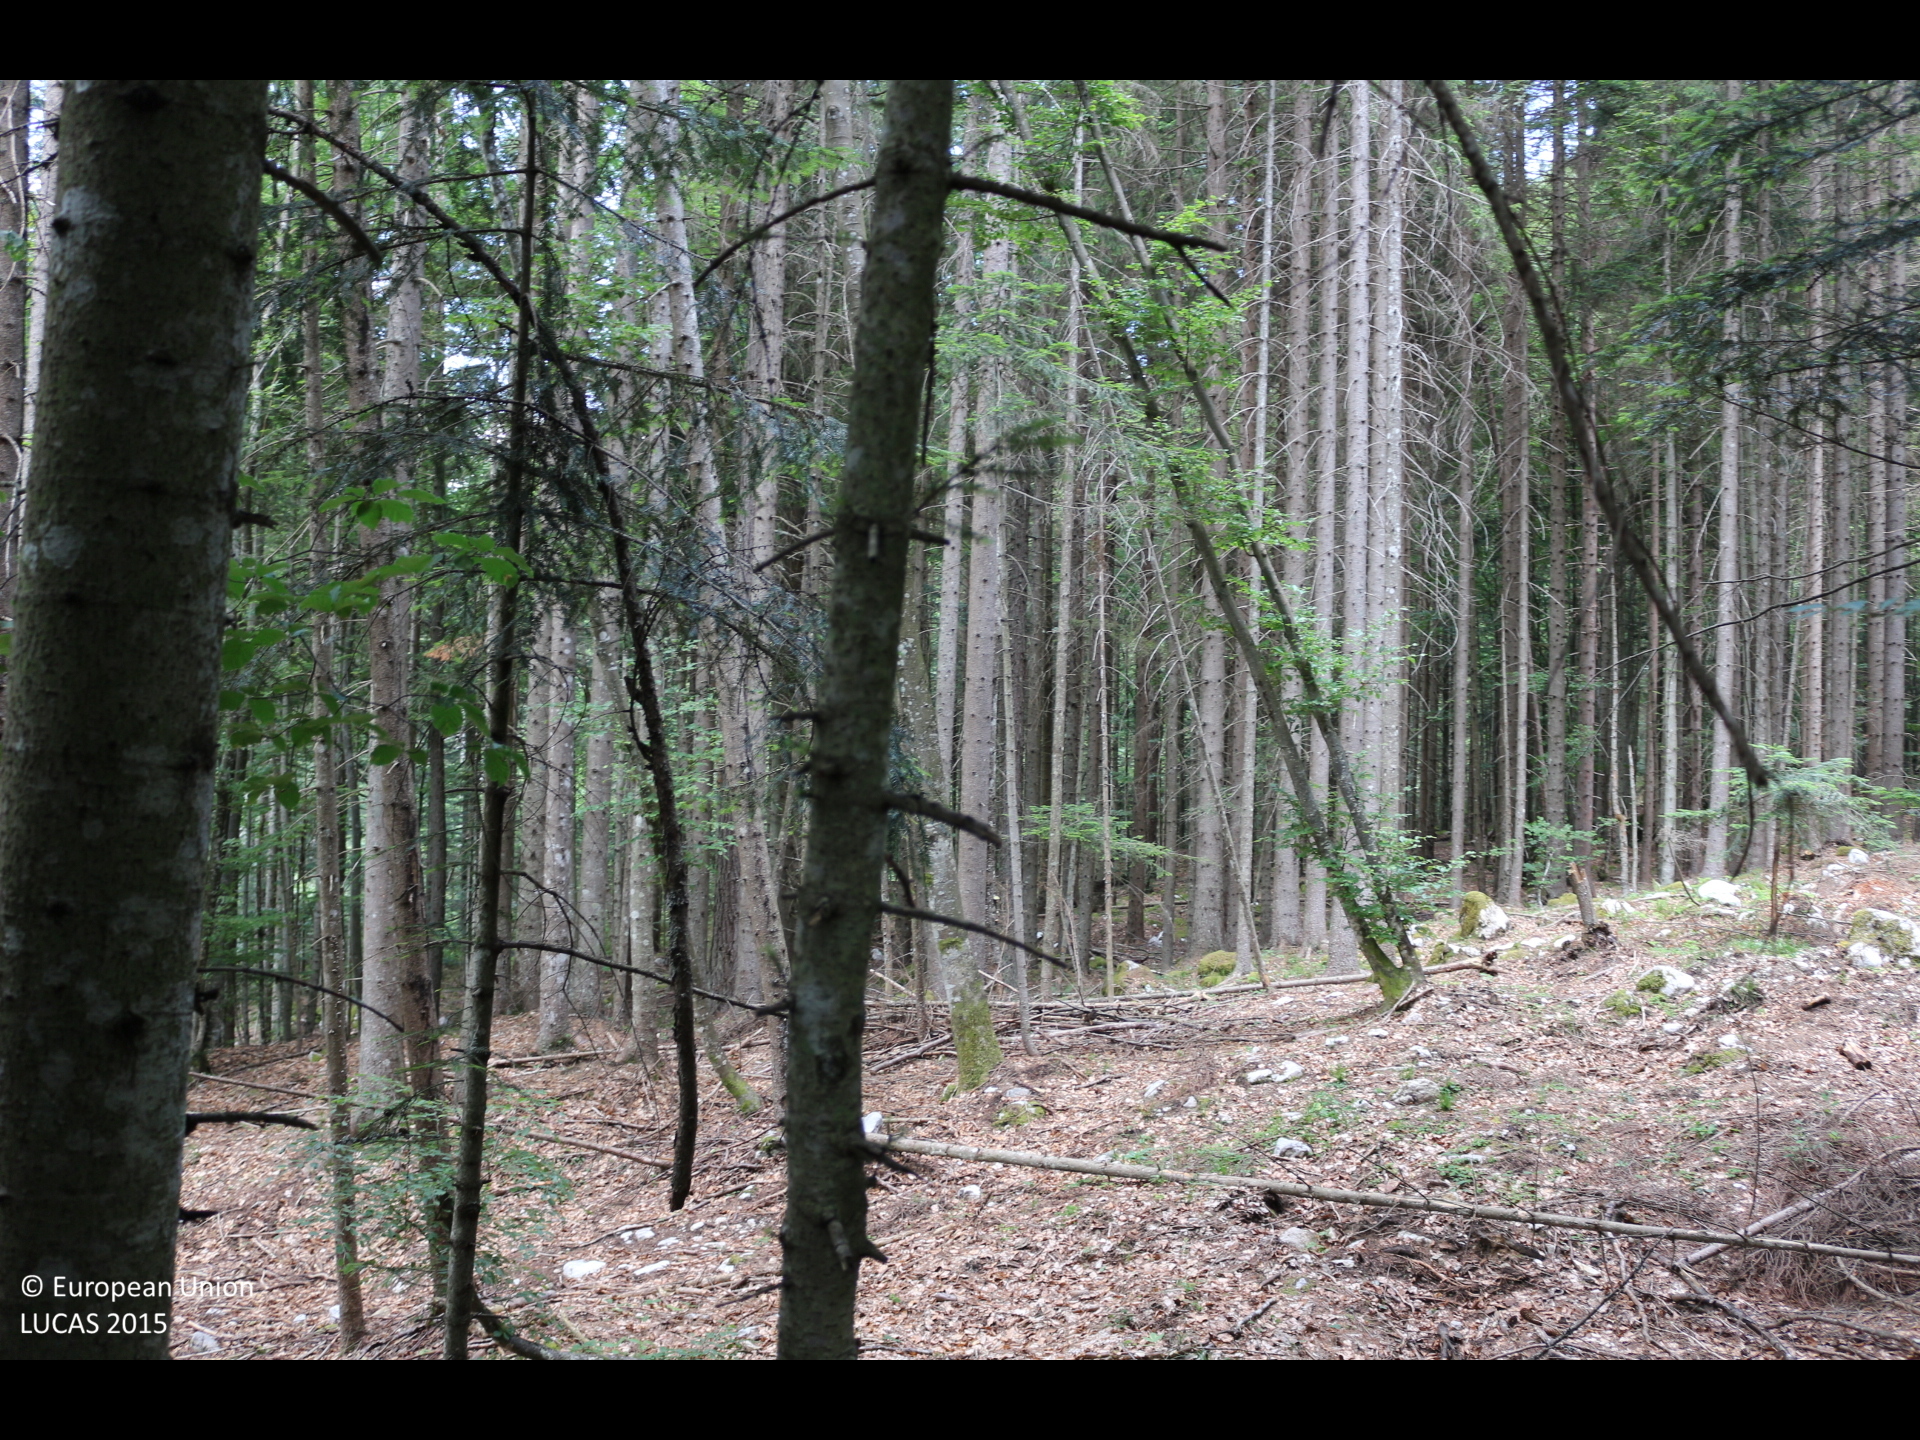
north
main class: Woodland
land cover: Spruce dominated mixed woodland
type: mountainous beech forest
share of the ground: > 75 %
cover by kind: broadleaved forest trees 60 %, coniferous forest trees 40 %
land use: Forestry
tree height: > 5 m
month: June
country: AT
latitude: 46.5308
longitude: 13.9475
